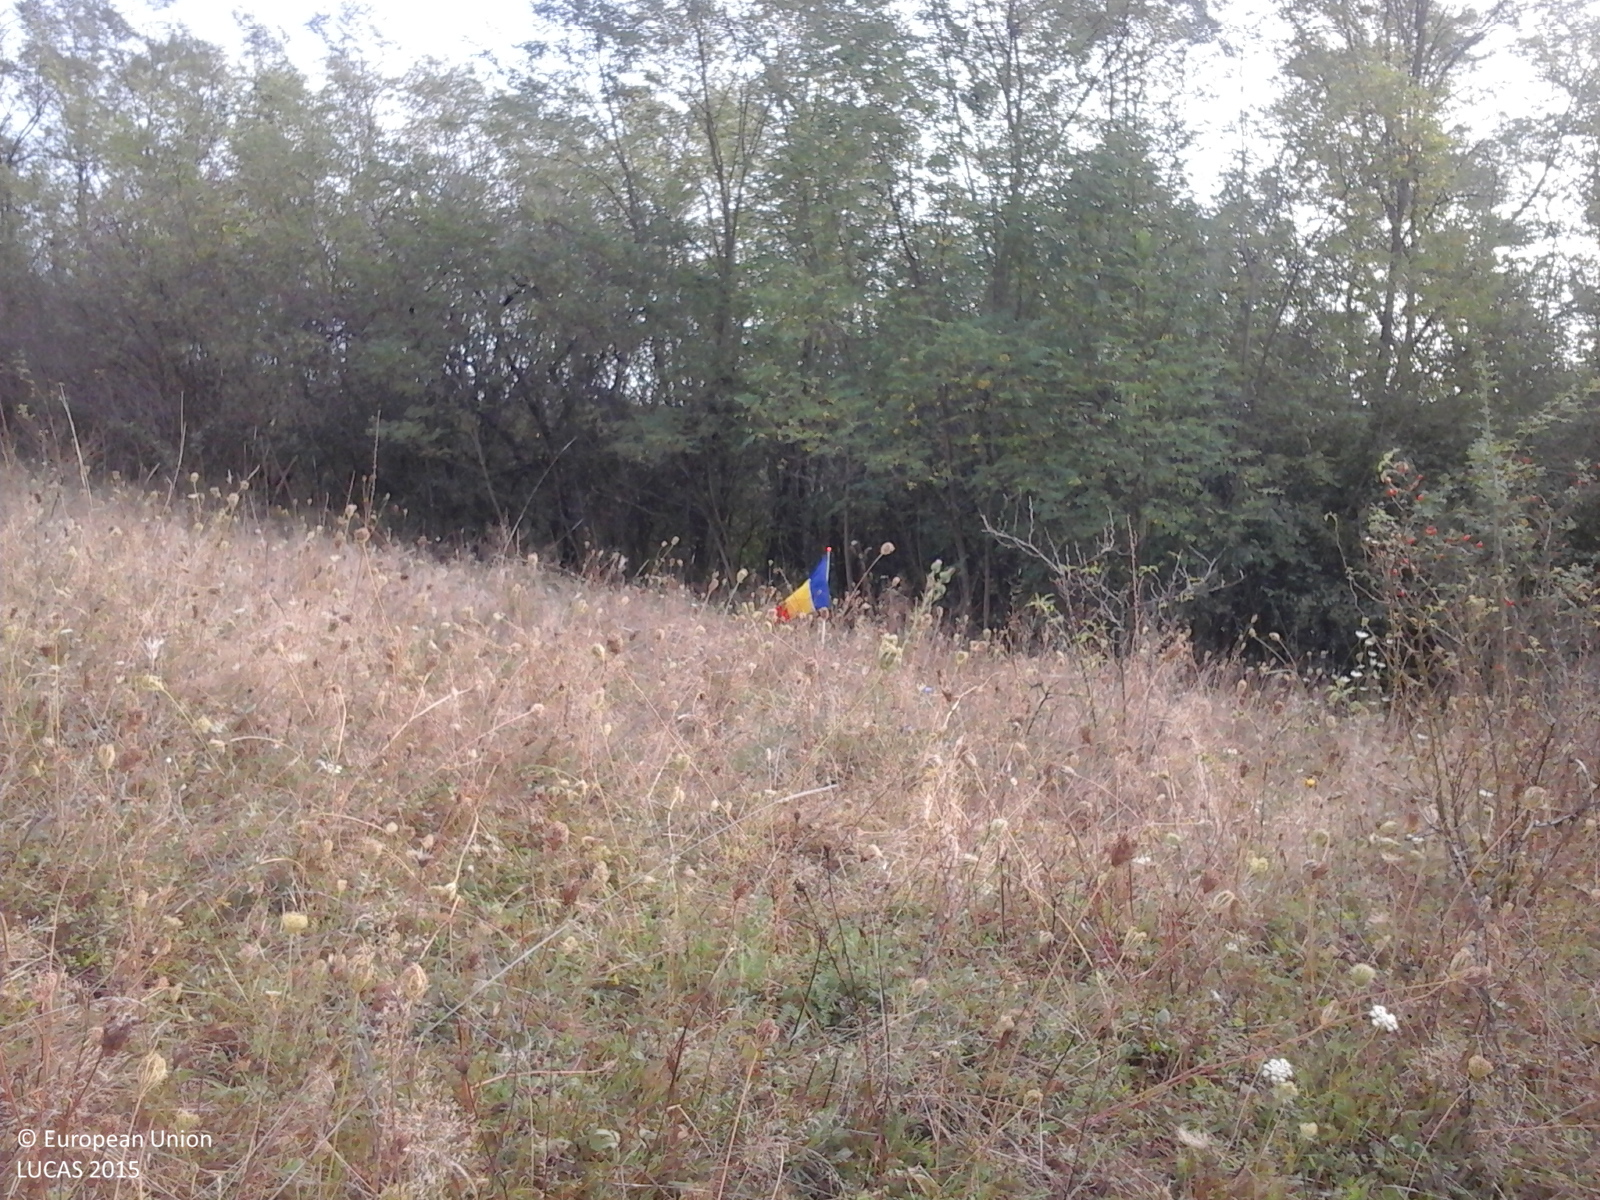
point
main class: Grassland
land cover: Grassland without tree/shrub cover
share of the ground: > 75 %
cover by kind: herbaceous plants 100 %
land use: Agriculture (excluding fallow land and kitchen gardens)
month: September
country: RO
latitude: 47.1565
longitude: 23.4585
